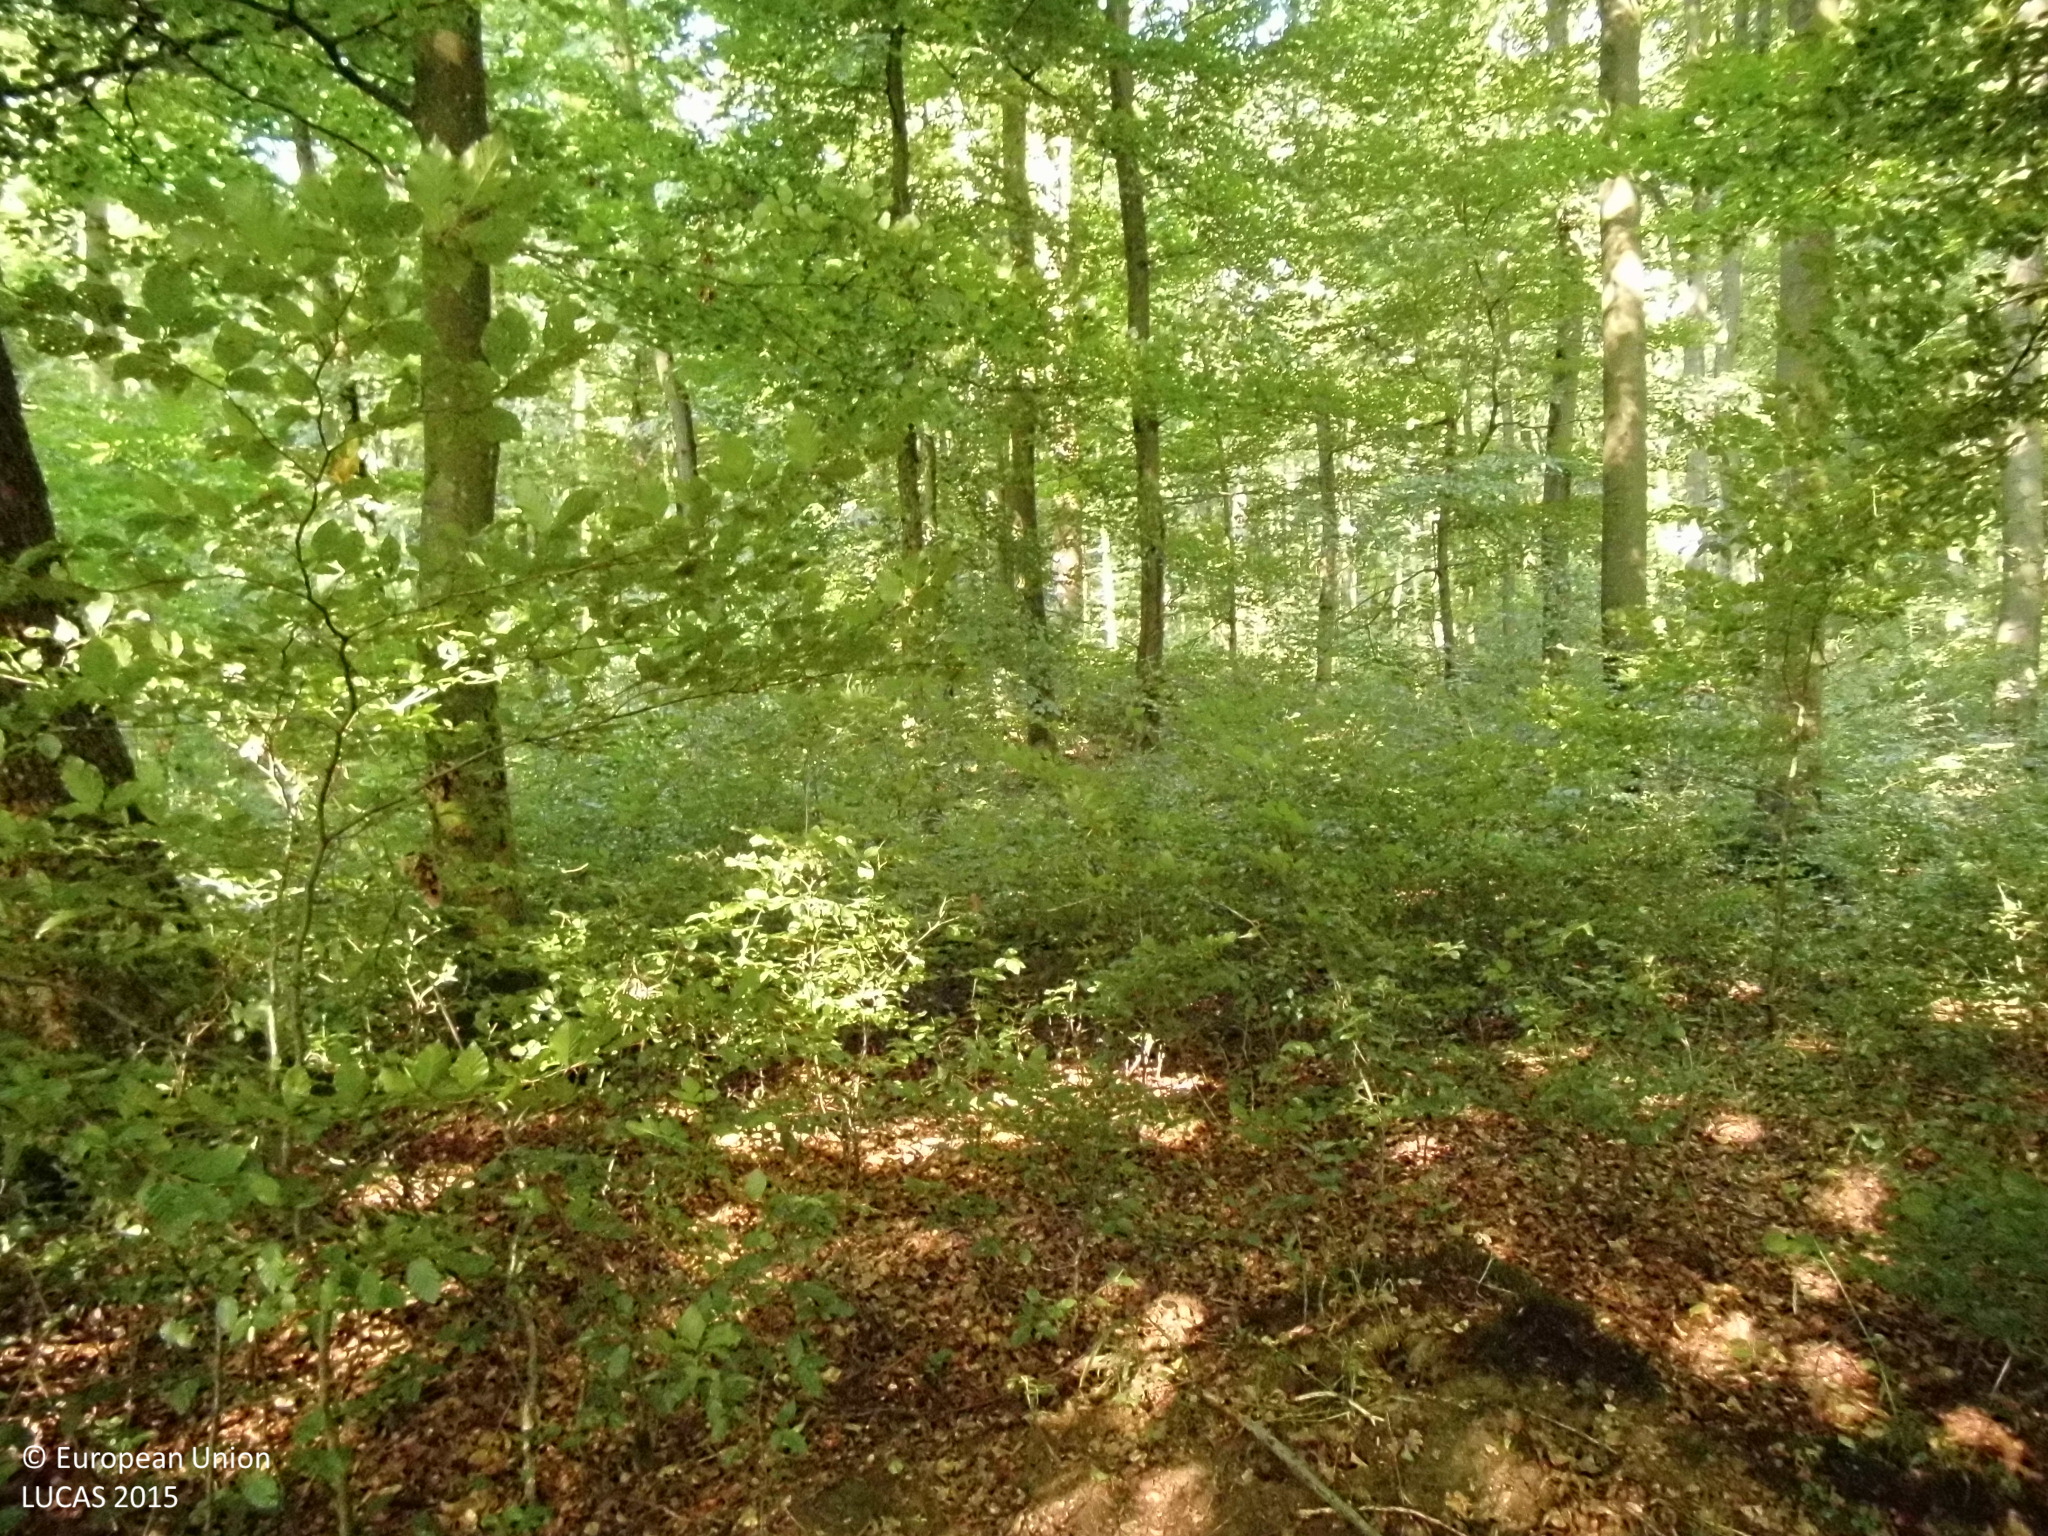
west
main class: Woodland
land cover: Broadleaved woodland
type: mesophytic deciduous forest
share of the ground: > 75 %
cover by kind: broadleaved forest trees 100 %
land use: Forestry
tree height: > 5 m
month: August
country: DE
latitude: 50.5985
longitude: 8.0083
